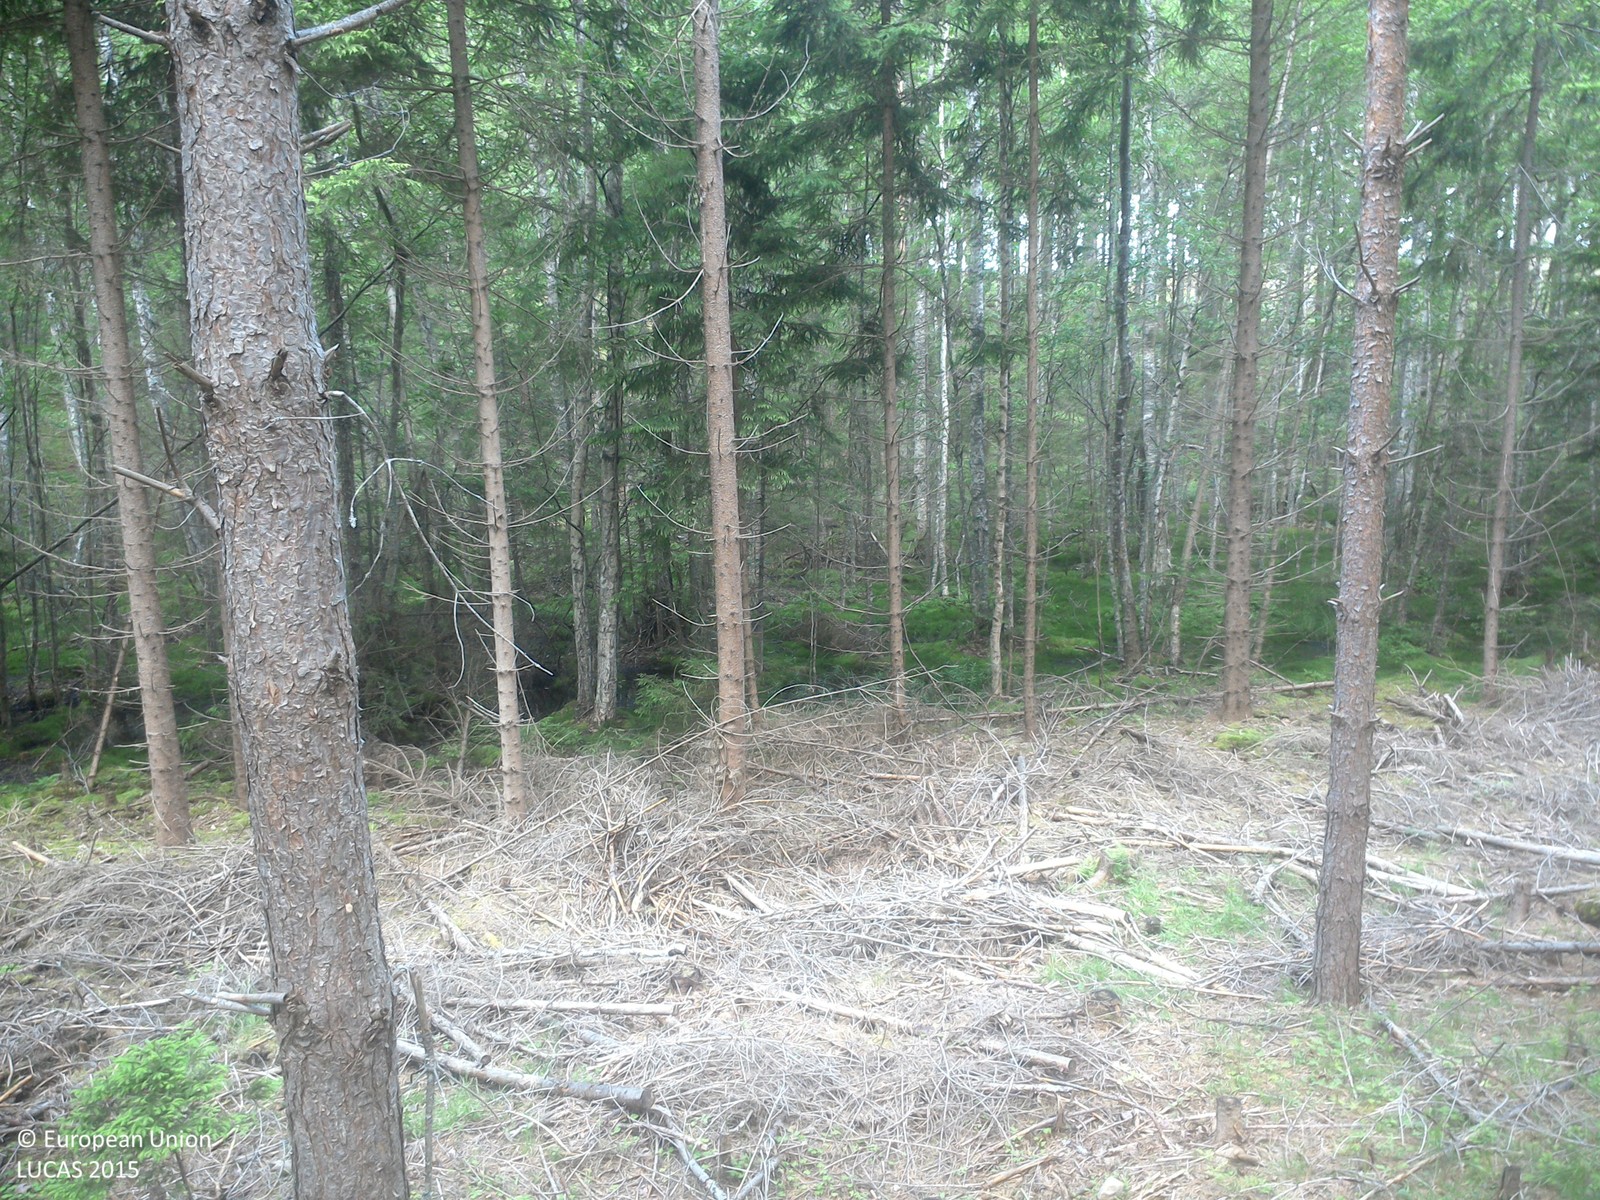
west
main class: Woodland
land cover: Pine dominated coniferous woodland
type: boreal forest
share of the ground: 50 - 75 %
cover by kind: coniferous forest trees 55 %, lichens and mosses 25 %, herbaceous plants 20 %
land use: Forestry
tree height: > 5 m
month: June
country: SE
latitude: 58.1877
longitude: 15.7272
